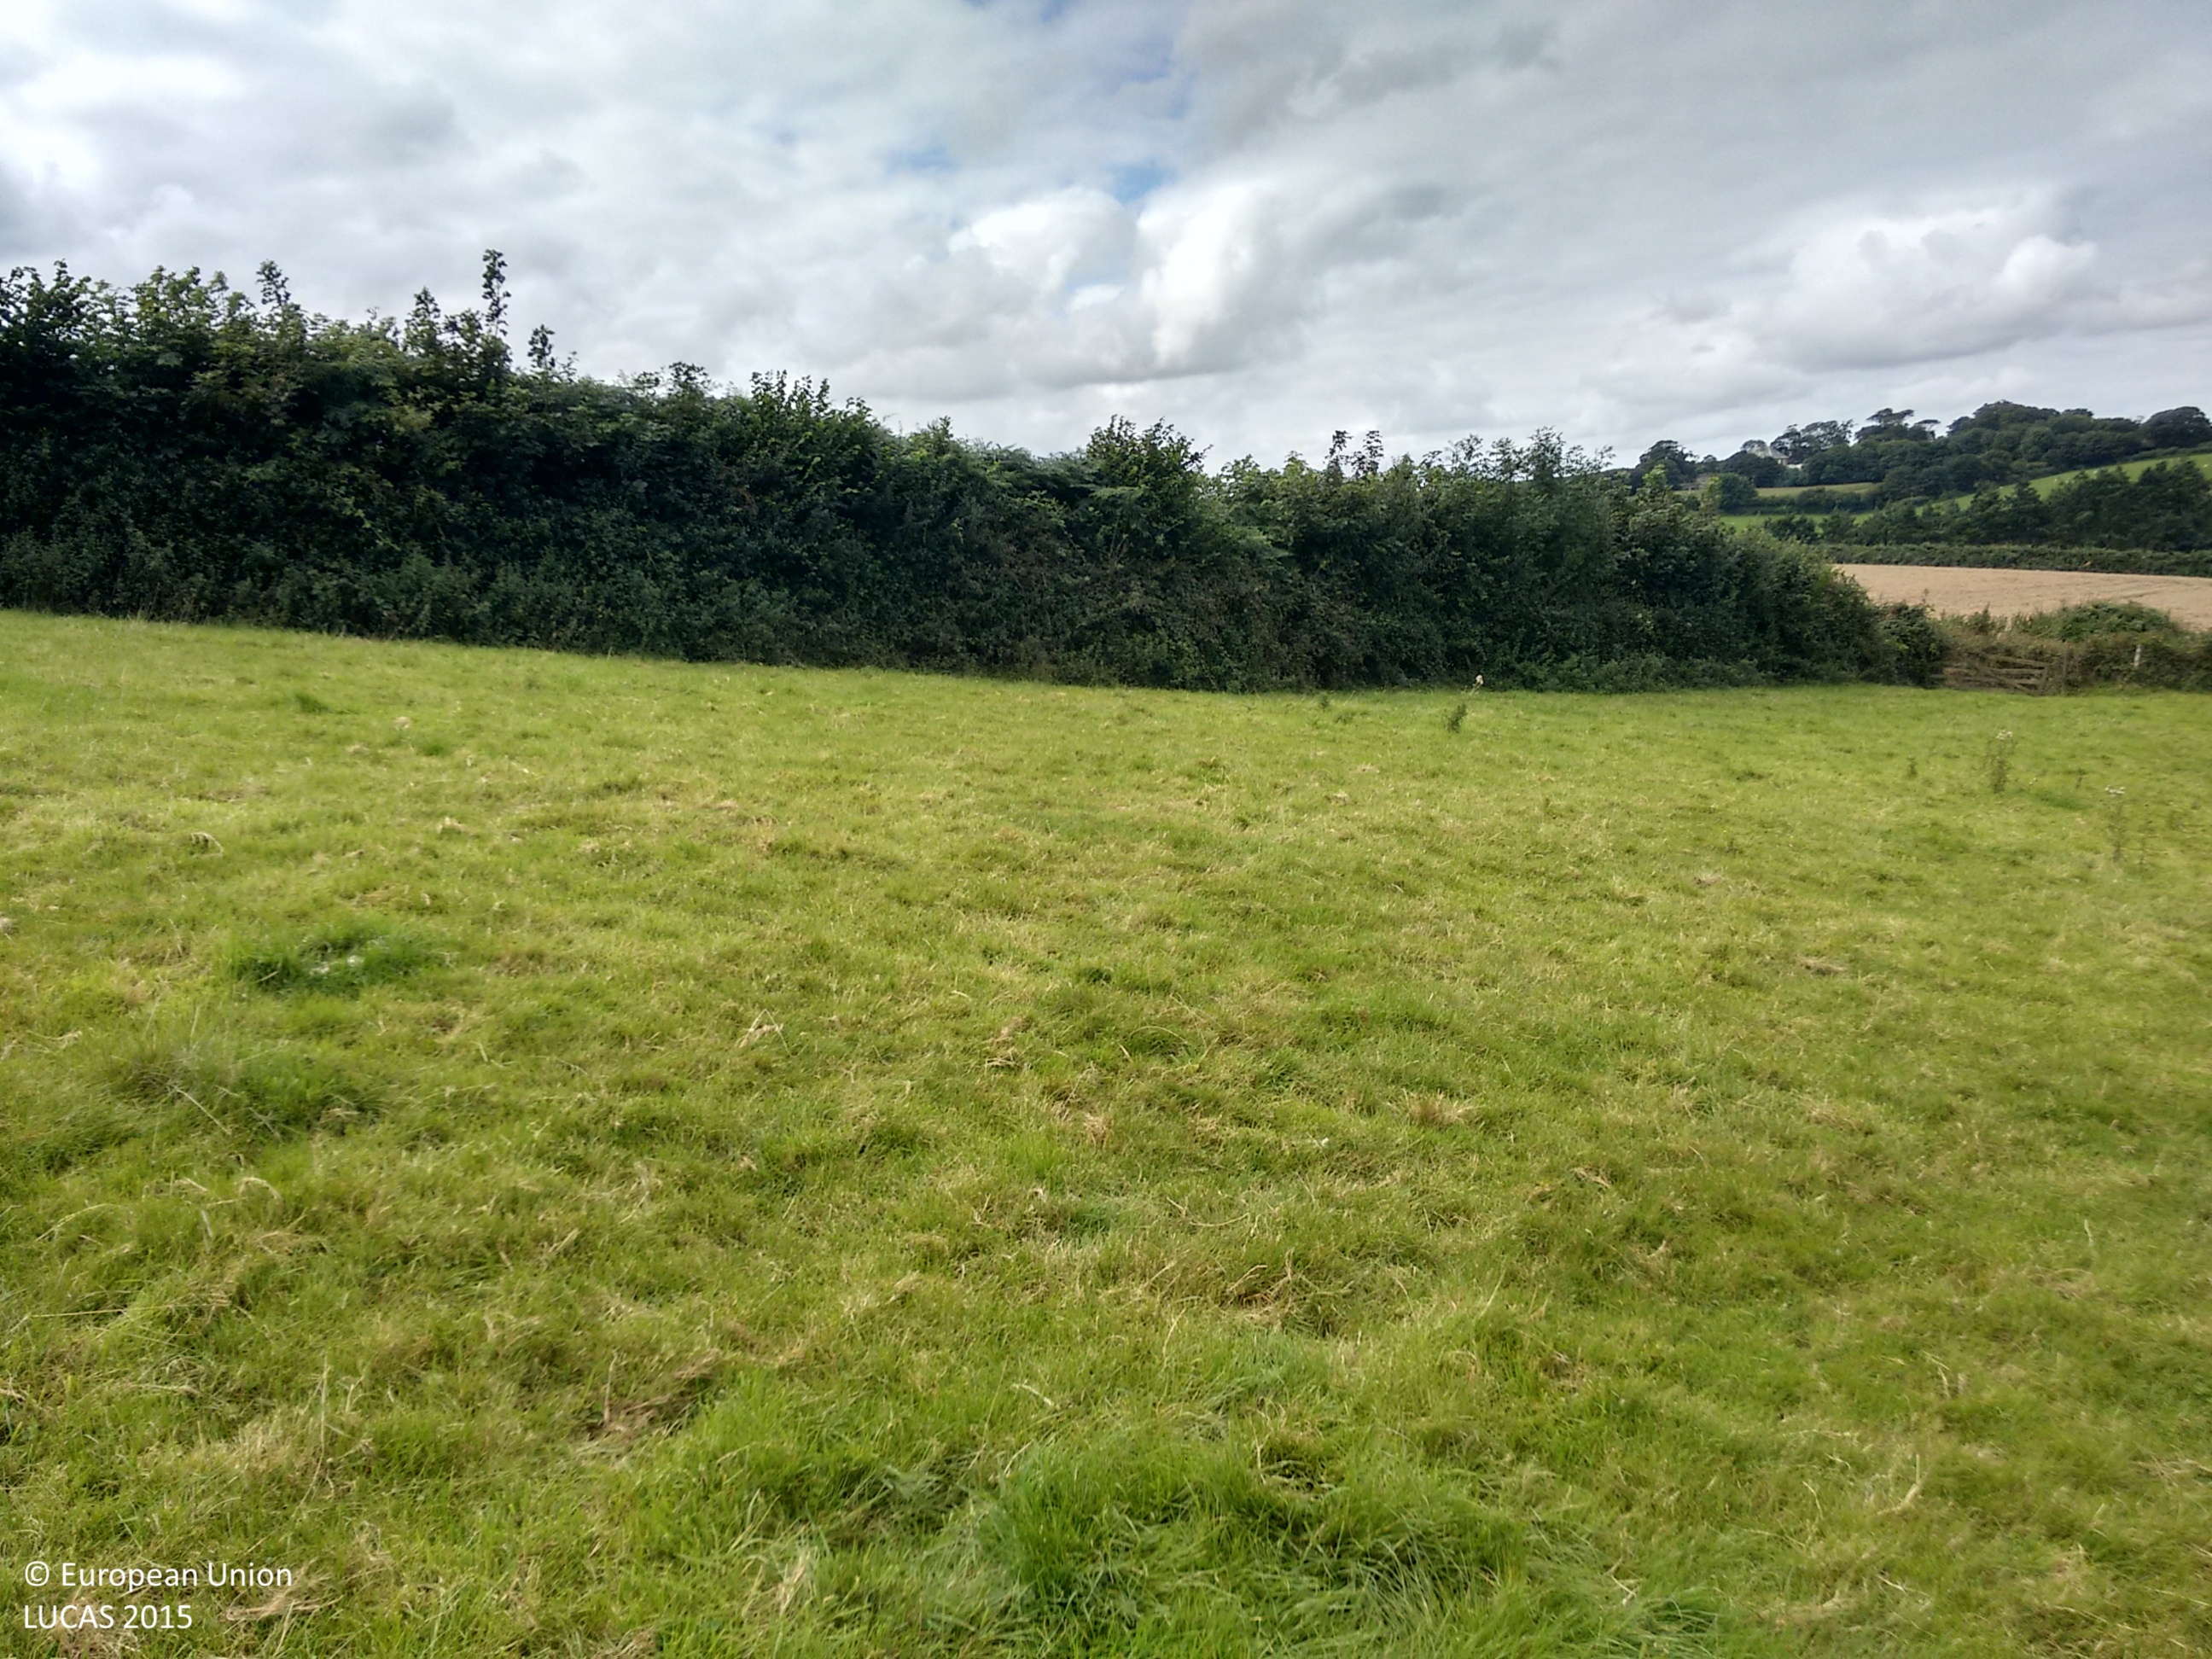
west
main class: Grassland
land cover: Grassland without tree/shrub cover
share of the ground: > 75 %
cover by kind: herbaceous plants 100 %
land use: Agriculture (excluding fallow land and kitchen gardens)
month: September
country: GB
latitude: 50.9086
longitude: -4.1047
